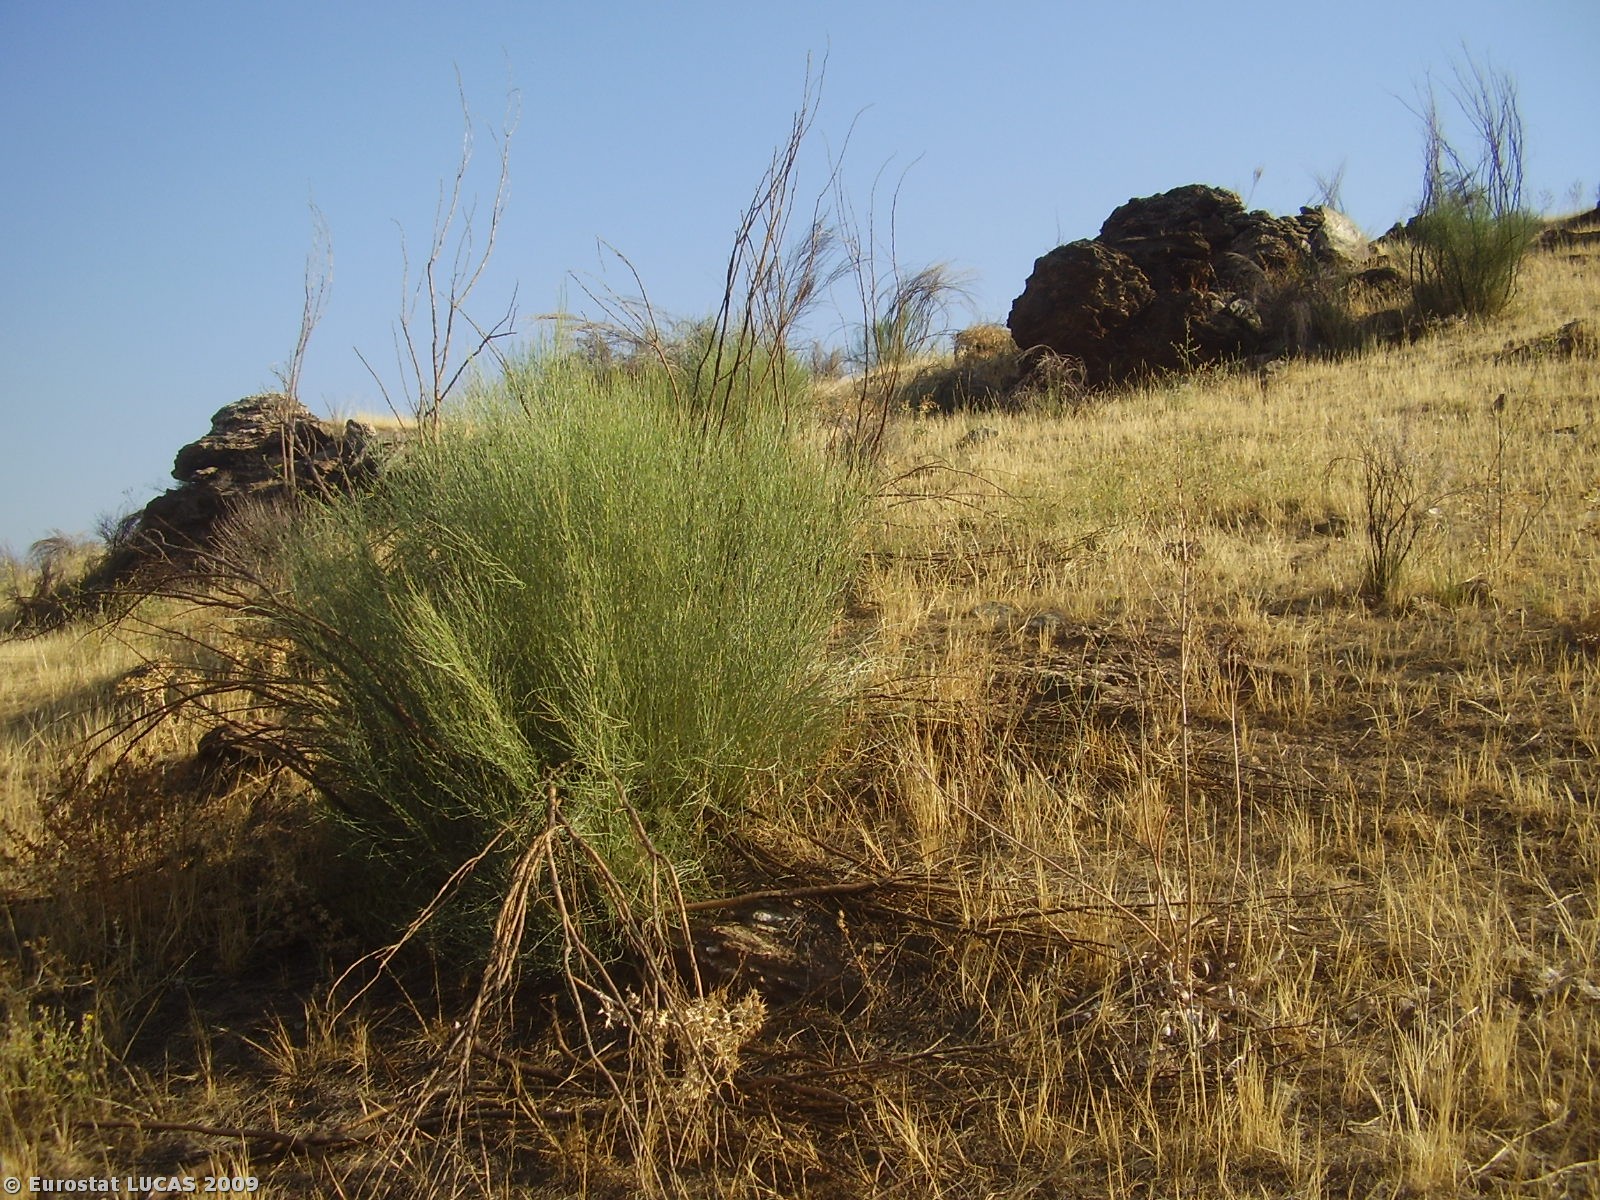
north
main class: Grassland
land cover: Spontaneously vegetated surfaces
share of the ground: > 75 %
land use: Fallow land
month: August
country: PT
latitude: 41.3301
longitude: -7.0193
